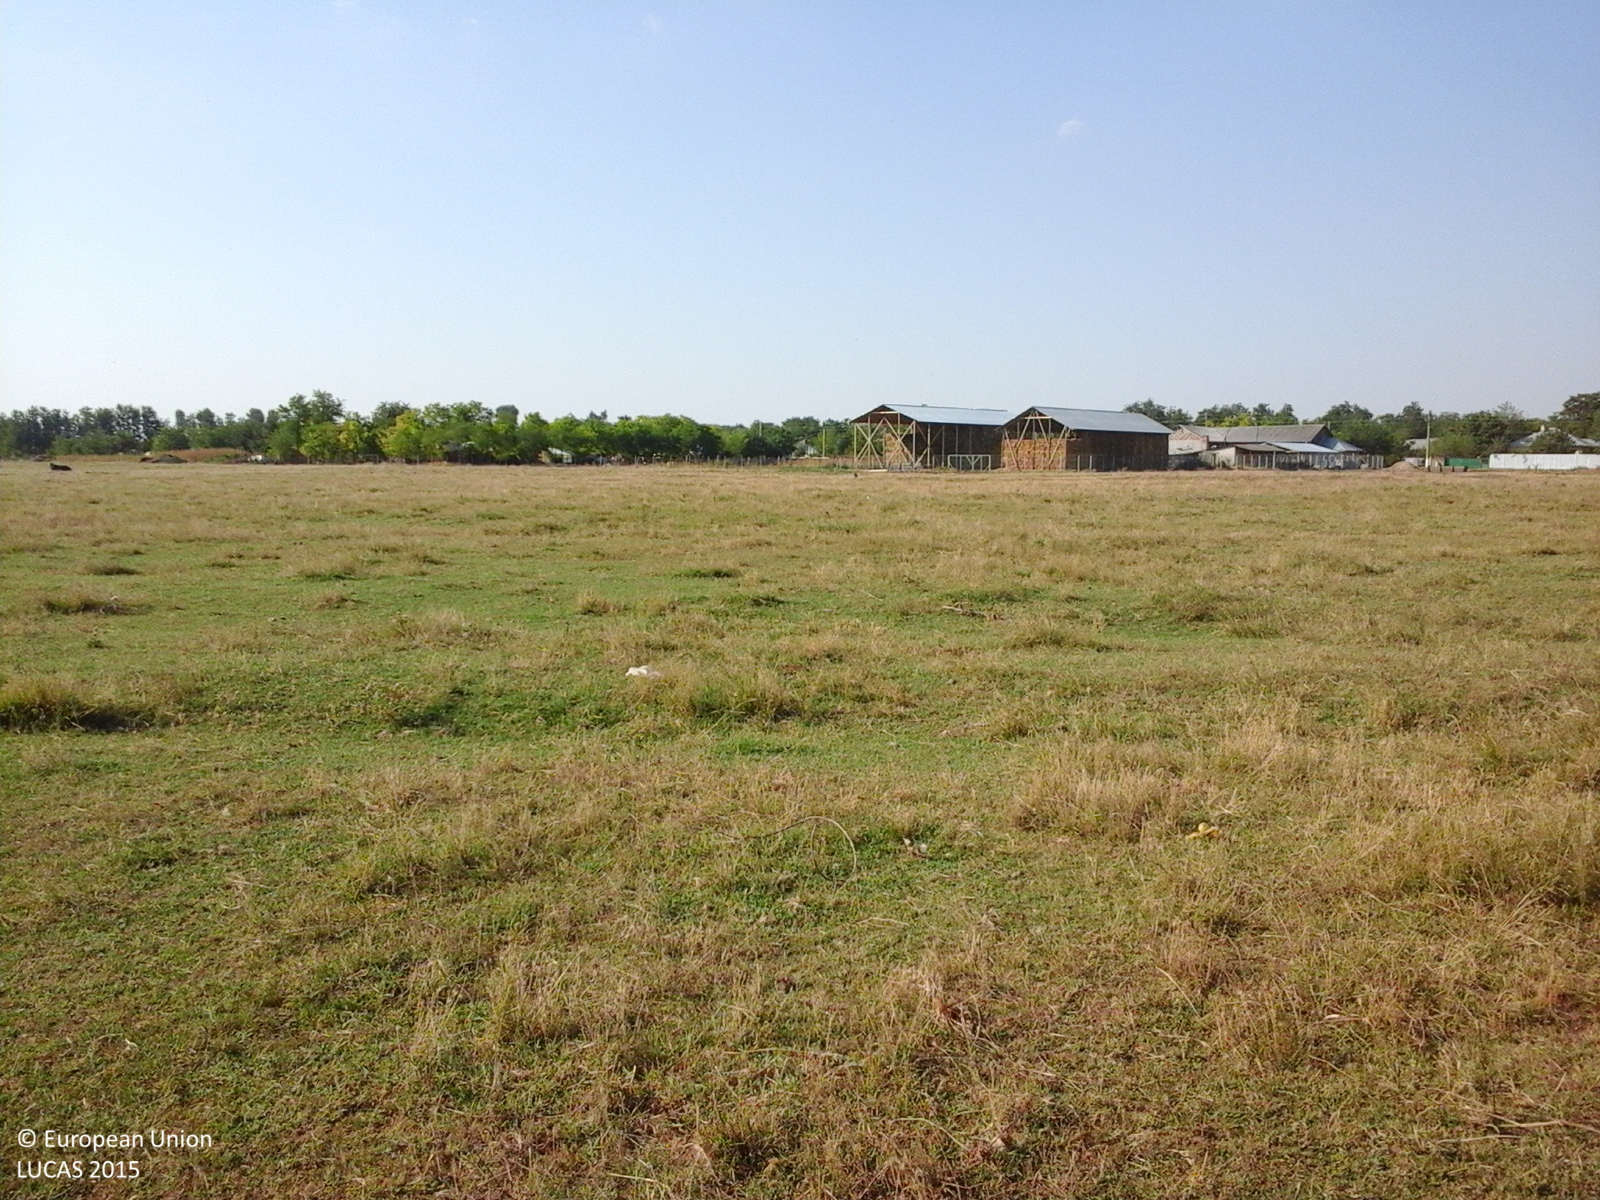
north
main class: Grassland
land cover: Grassland without tree/shrub cover
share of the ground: > 75 %
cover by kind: herbaceous plants 100 %
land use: Agriculture (excluding fallow land and kitchen gardens)
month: July
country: RO
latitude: 44.8037
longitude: 27.2706
